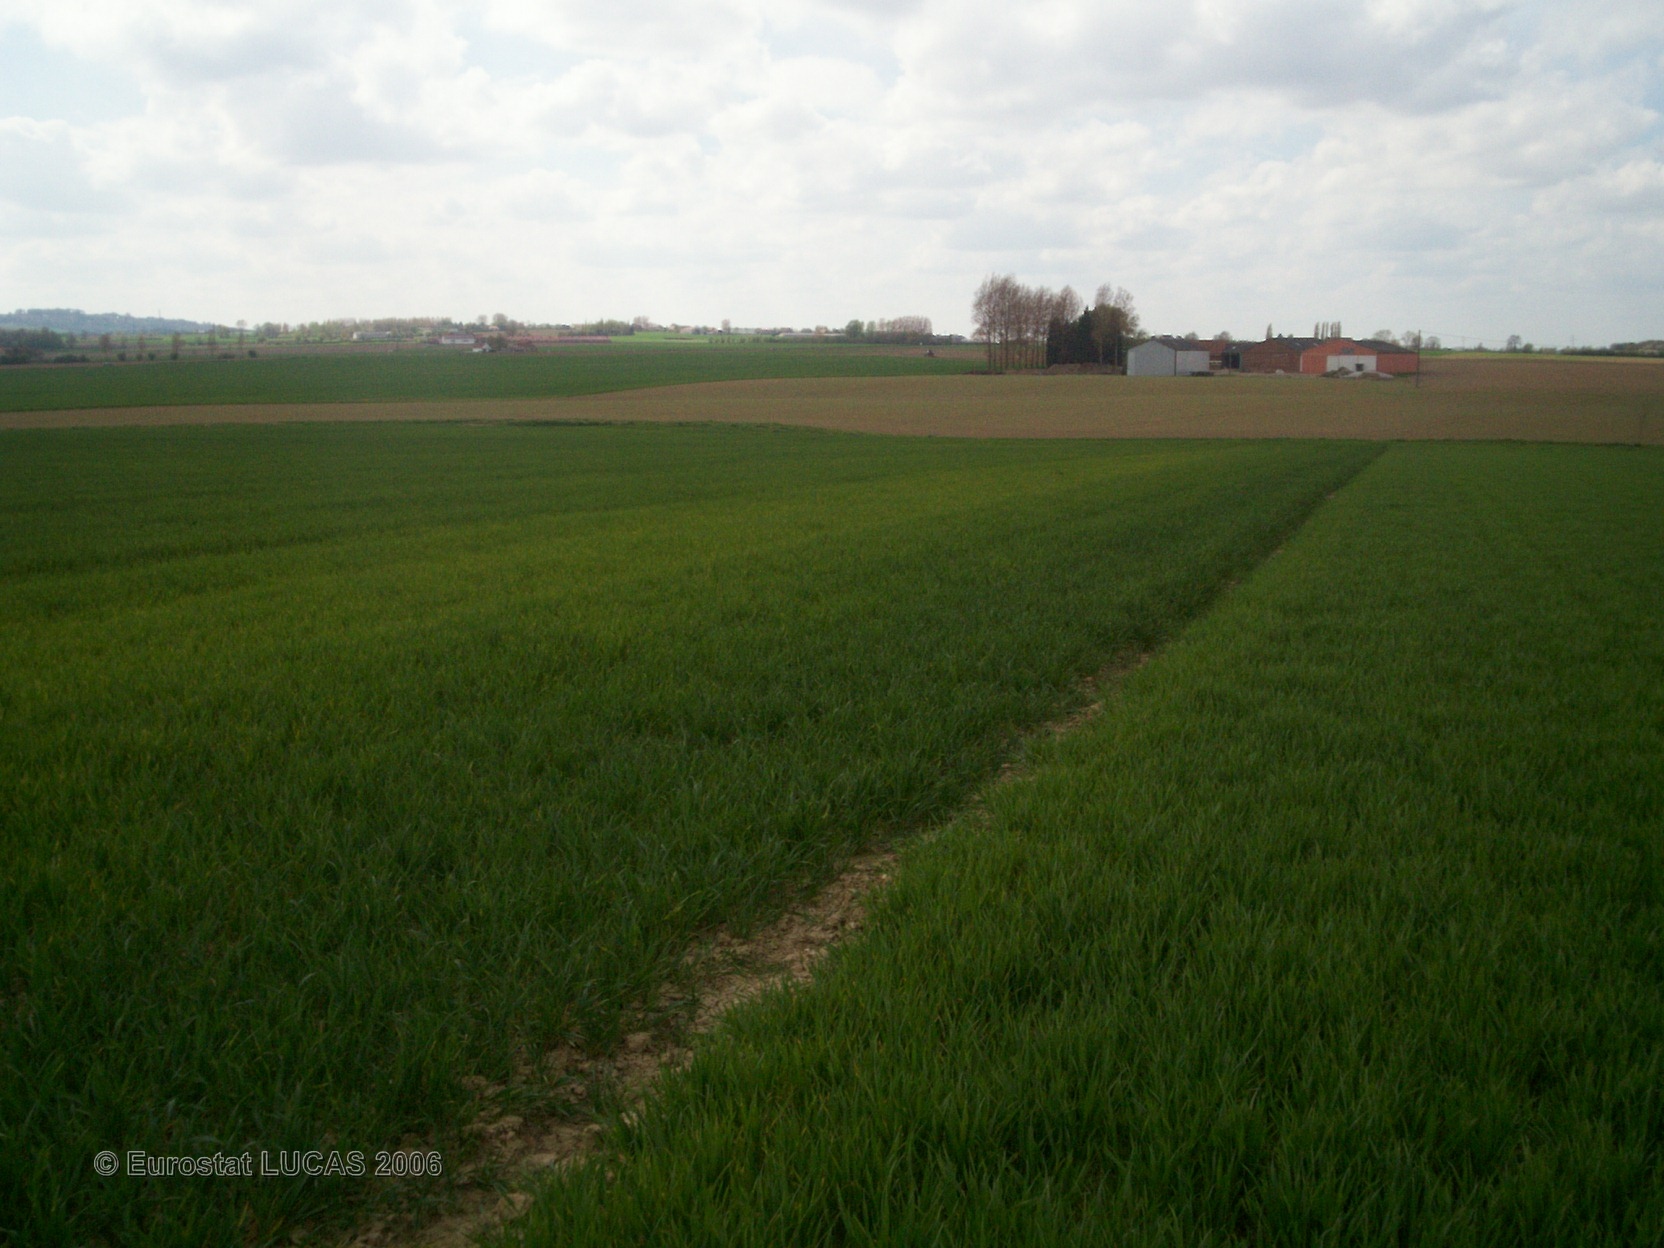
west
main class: Cropland
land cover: Common wheat
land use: Agriculture (excluding fallow land and kitchen gardens)
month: May
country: FR
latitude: 50.8260
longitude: 2.5628
